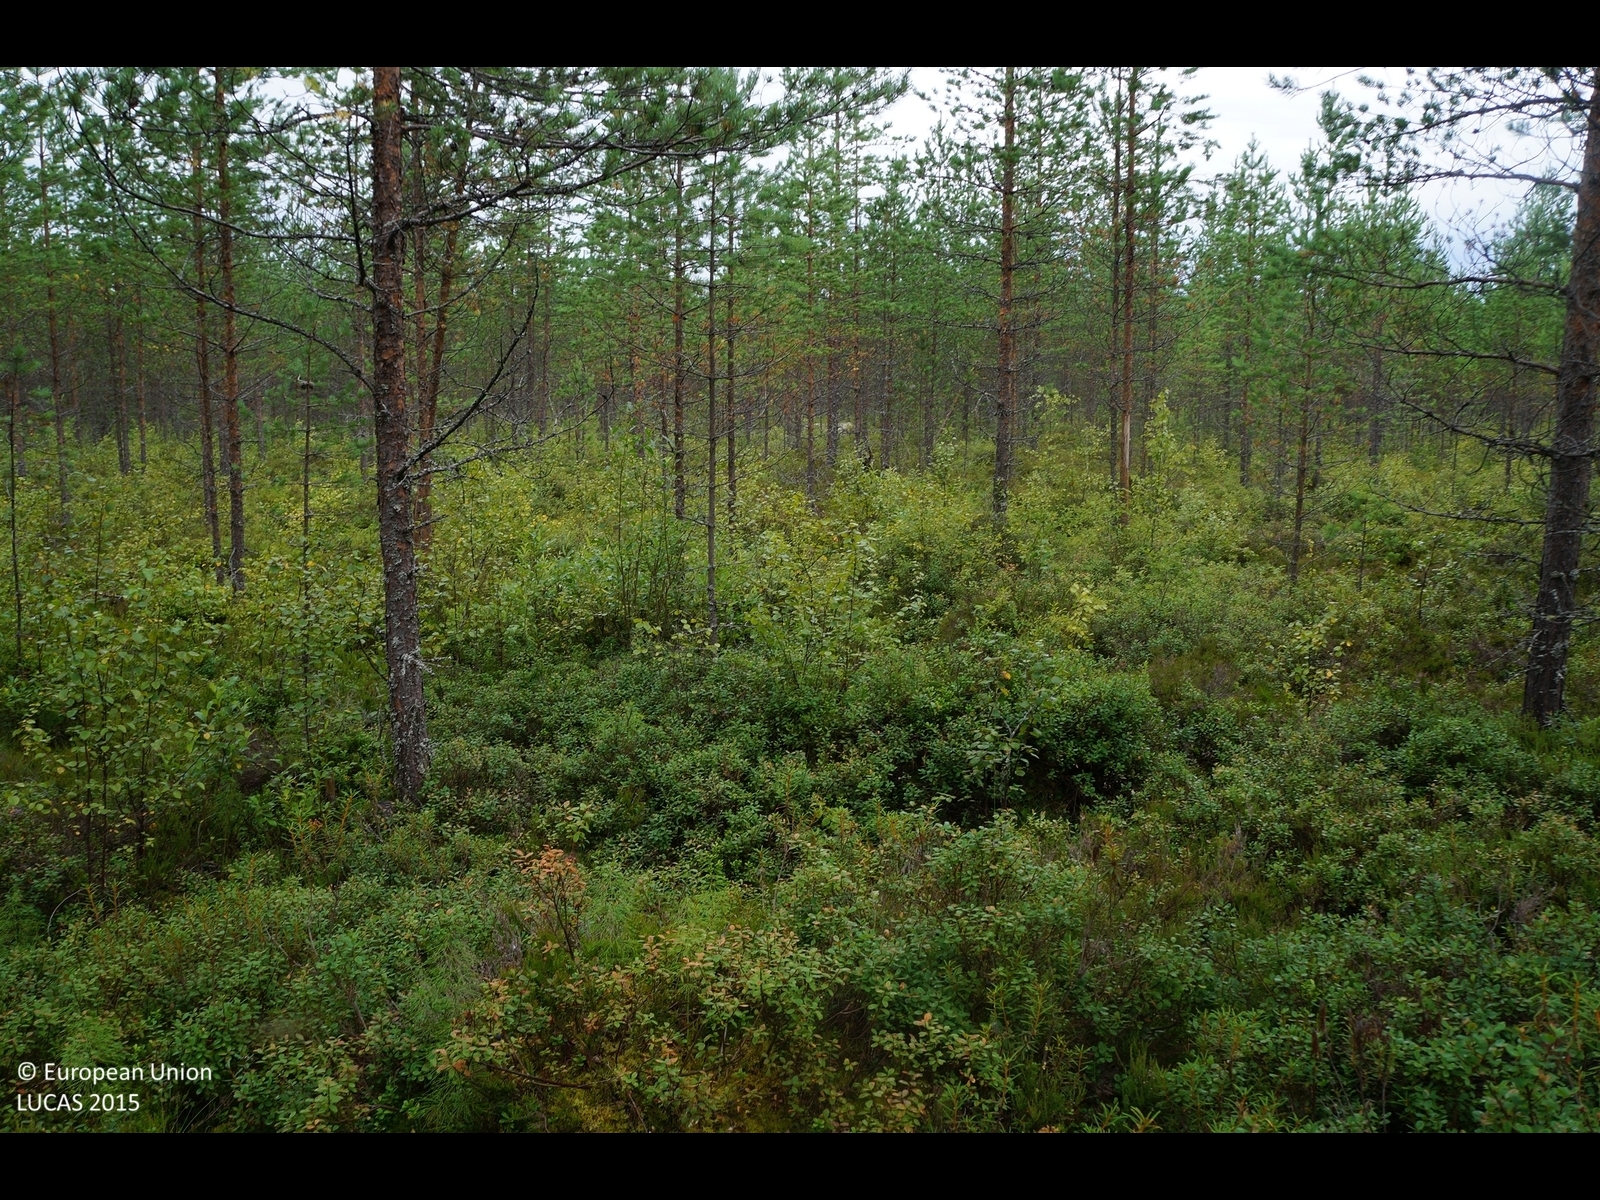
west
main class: Woodland
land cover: Pine dominated coniferous woodland
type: boreal forest
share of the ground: 25 - 50 %
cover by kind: shrubs 50 %, coniferous forest trees 35 %, lichens and mosses 10 %, broadleaved forest trees 5 %
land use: Forestry
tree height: > 5 m
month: August
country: FI
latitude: 64.2872
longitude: 25.9478
